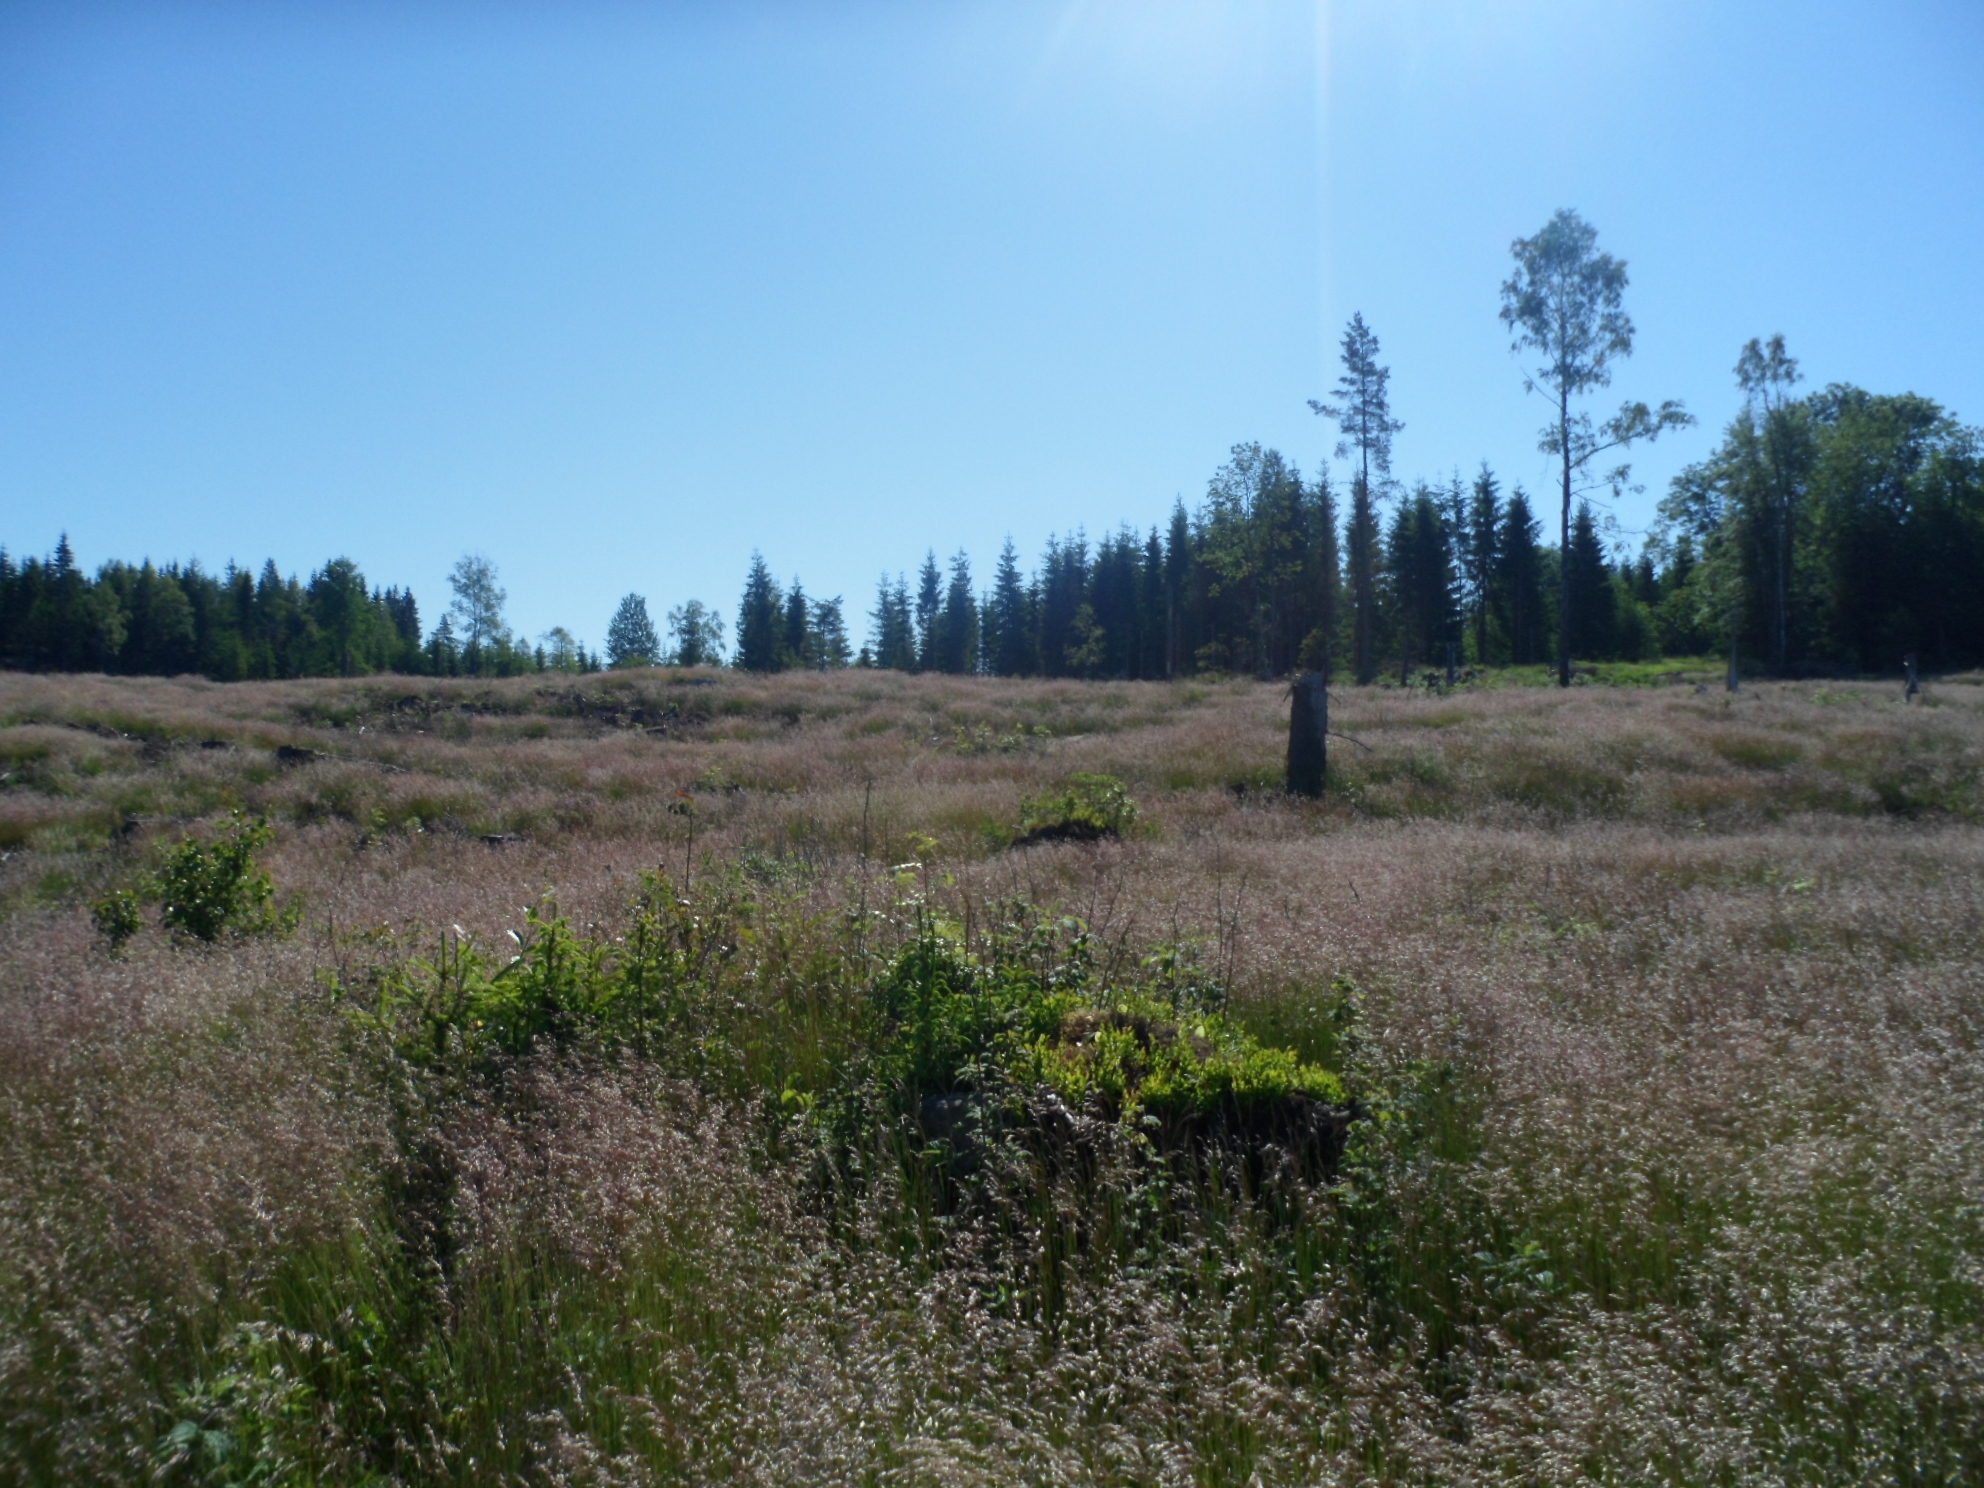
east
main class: Grassland
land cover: Grassland with sparse tree/shrub cover
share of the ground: > 75 %
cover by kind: herbaceous plants 85 %, coniferous forest trees 5 %, shrubs 5 %, lichens and mosses 5 %
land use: Forestry
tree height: < 5 m
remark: Clear cut
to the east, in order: Grassland with sparse tree/shrub cover; Spruce dominated coniferous woodland; Dry stone walls; Spruce dominated coniferous woodland; Spruce dominated mixed woodland; Dry stone walls; Spruce dominated coniferous woodland; Grassland with sparse tree/shrub cover
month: July
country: SE
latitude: 57.4581
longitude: 14.5462
